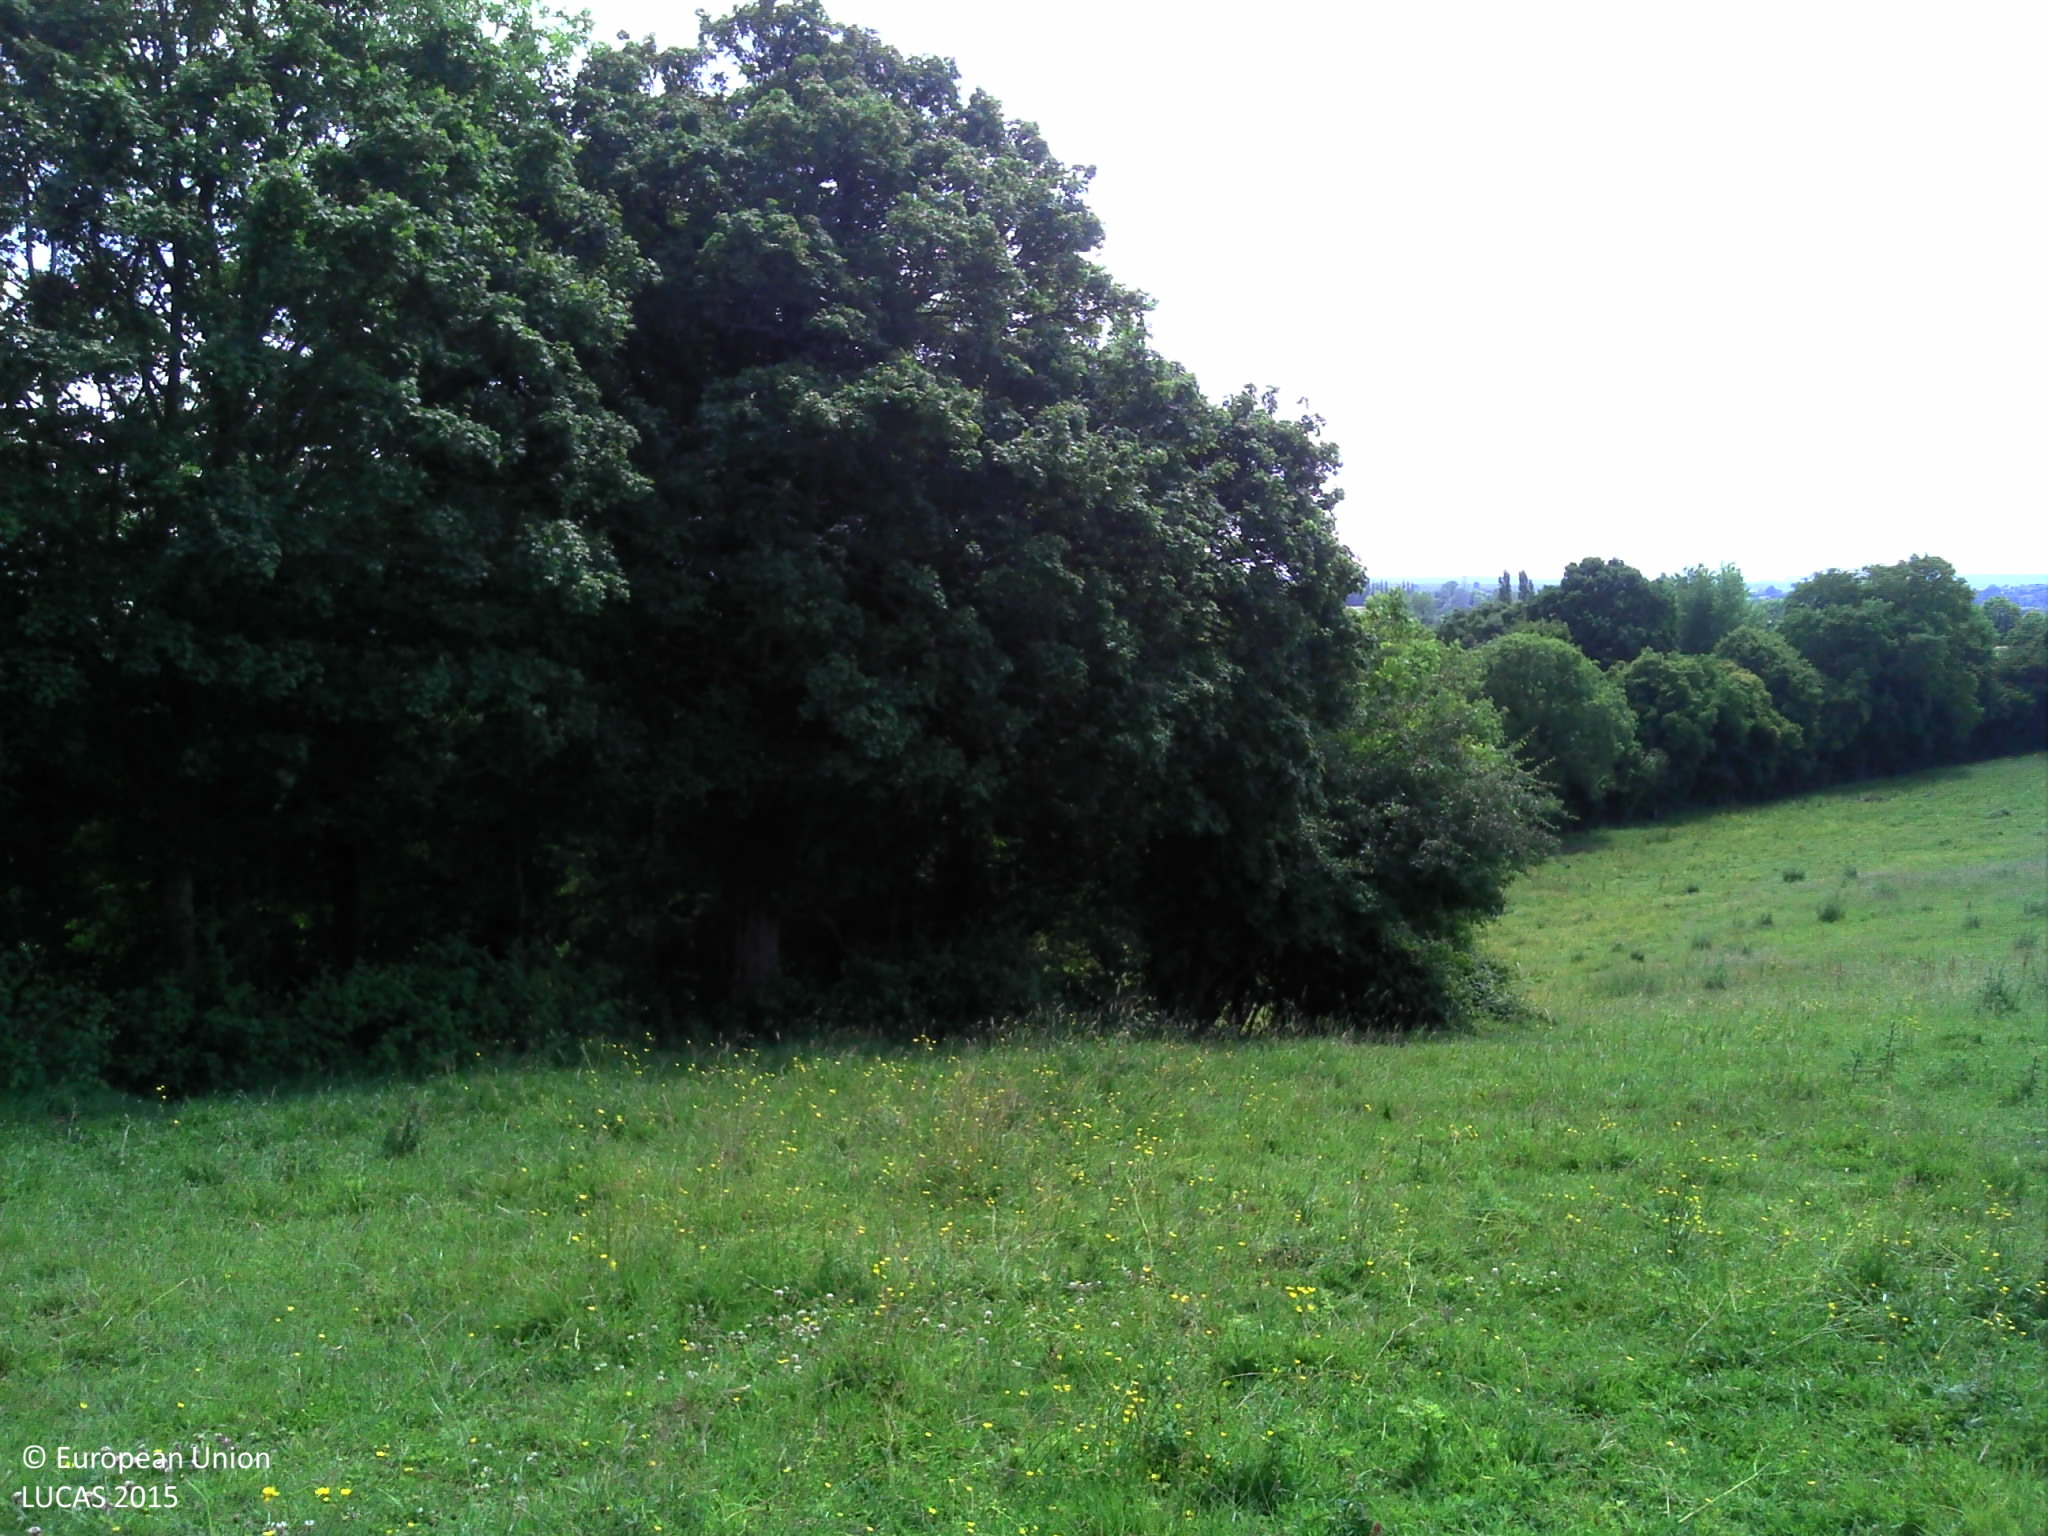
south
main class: Grassland
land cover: Grassland without tree/shrub cover
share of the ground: > 75 %
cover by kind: herbaceous plants 100 %
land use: Agriculture (excluding fallow land and kitchen gardens)
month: June
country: FR
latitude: 49.1966
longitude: -0.0356
